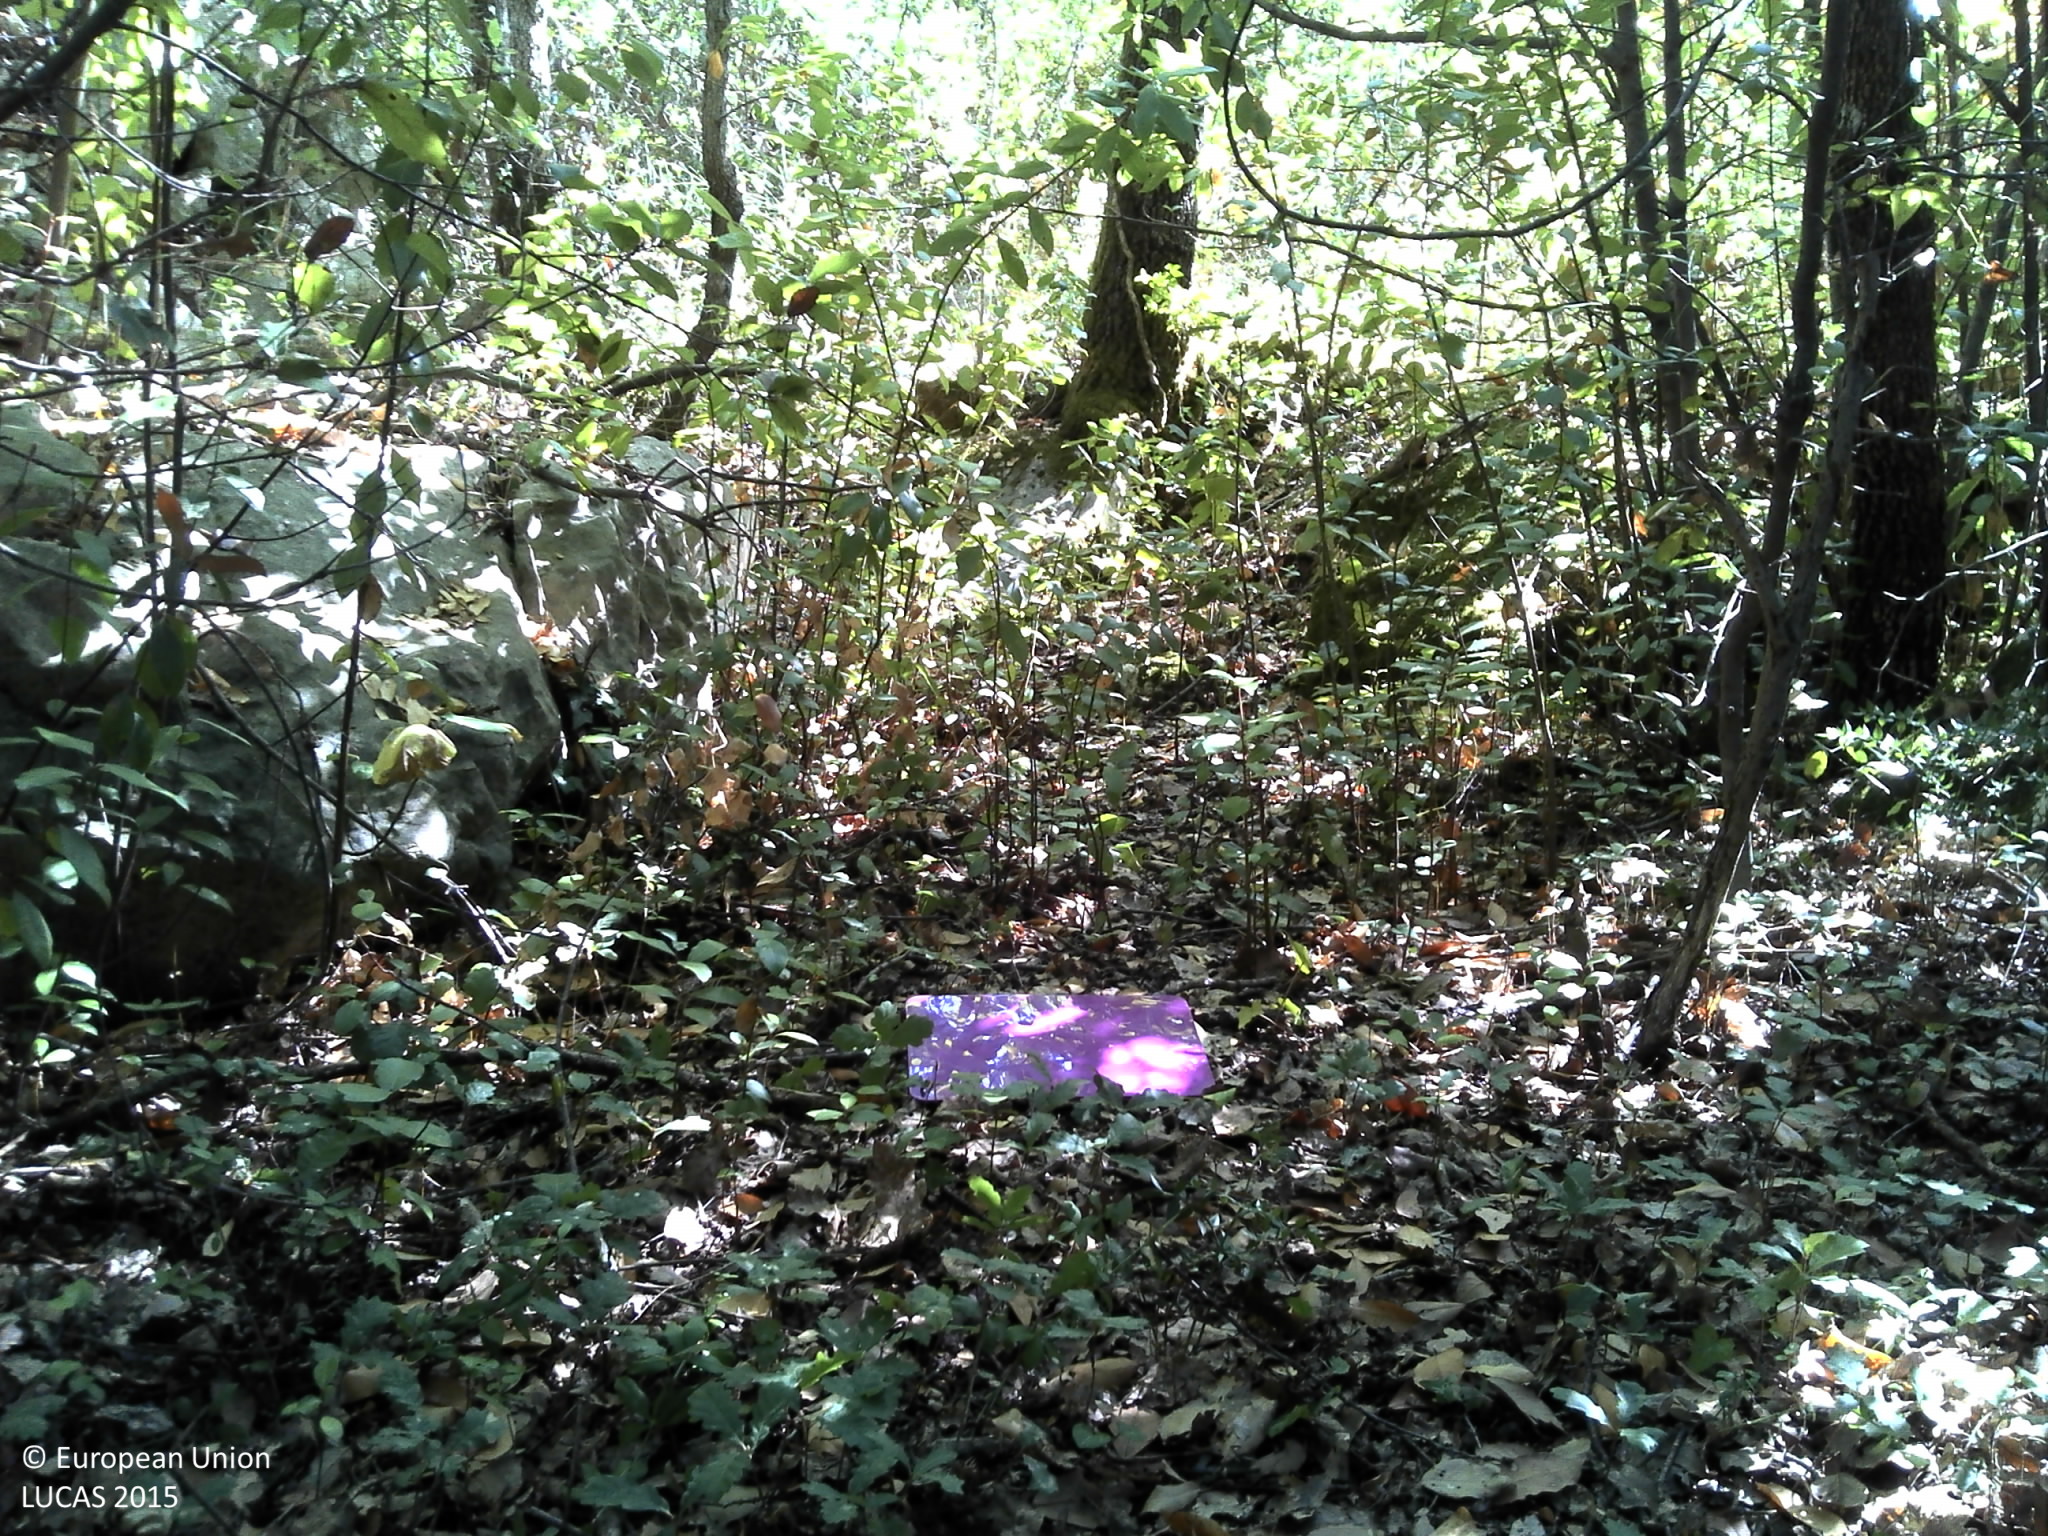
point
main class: Woodland
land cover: Other mixed woodland
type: coniferous forest of the mediterranean region
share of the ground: 25 - 50 %
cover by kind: coniferous forest trees 30 %, herbaceous plants 30 %, broadleaved forest trees 20 %, shrubs 10 %, unconsolidated bare surface 10 %
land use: Semi-natural and natural areas not in use
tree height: > 5 m
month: July
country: HR
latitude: 42.7625
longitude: 17.8964
